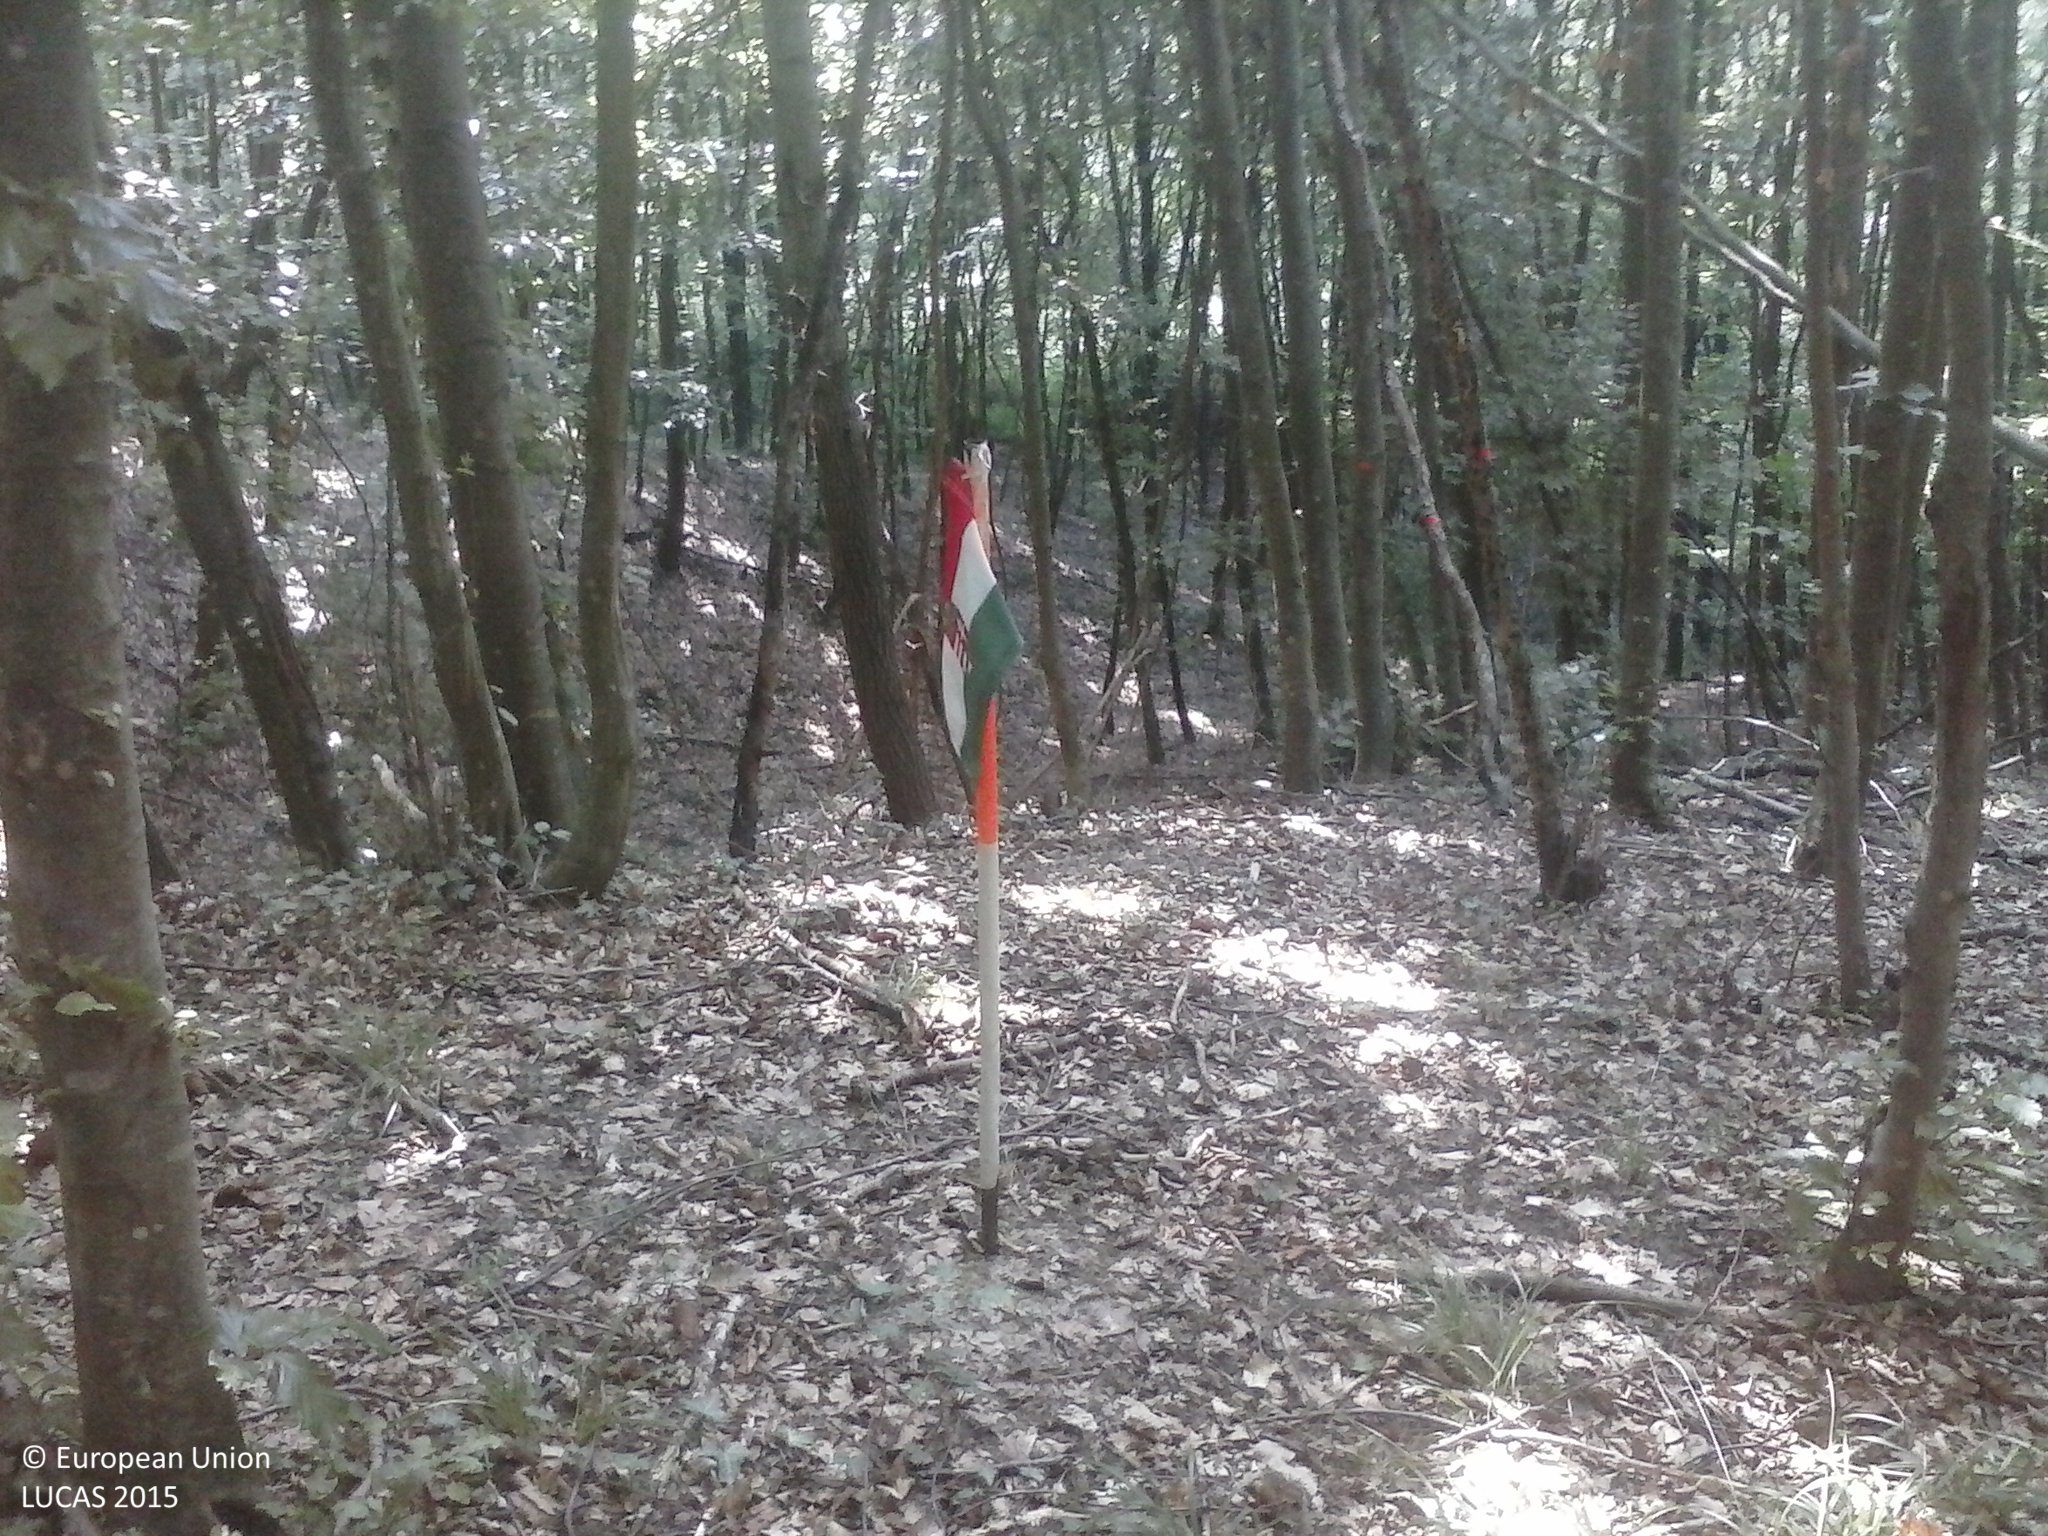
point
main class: Woodland
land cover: Broadleaved woodland
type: beech forest
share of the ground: > 75 %
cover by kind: broadleaved forest trees 100 %
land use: Forestry
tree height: > 5 m
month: August
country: HU
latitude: 46.1198
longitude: 17.8082
